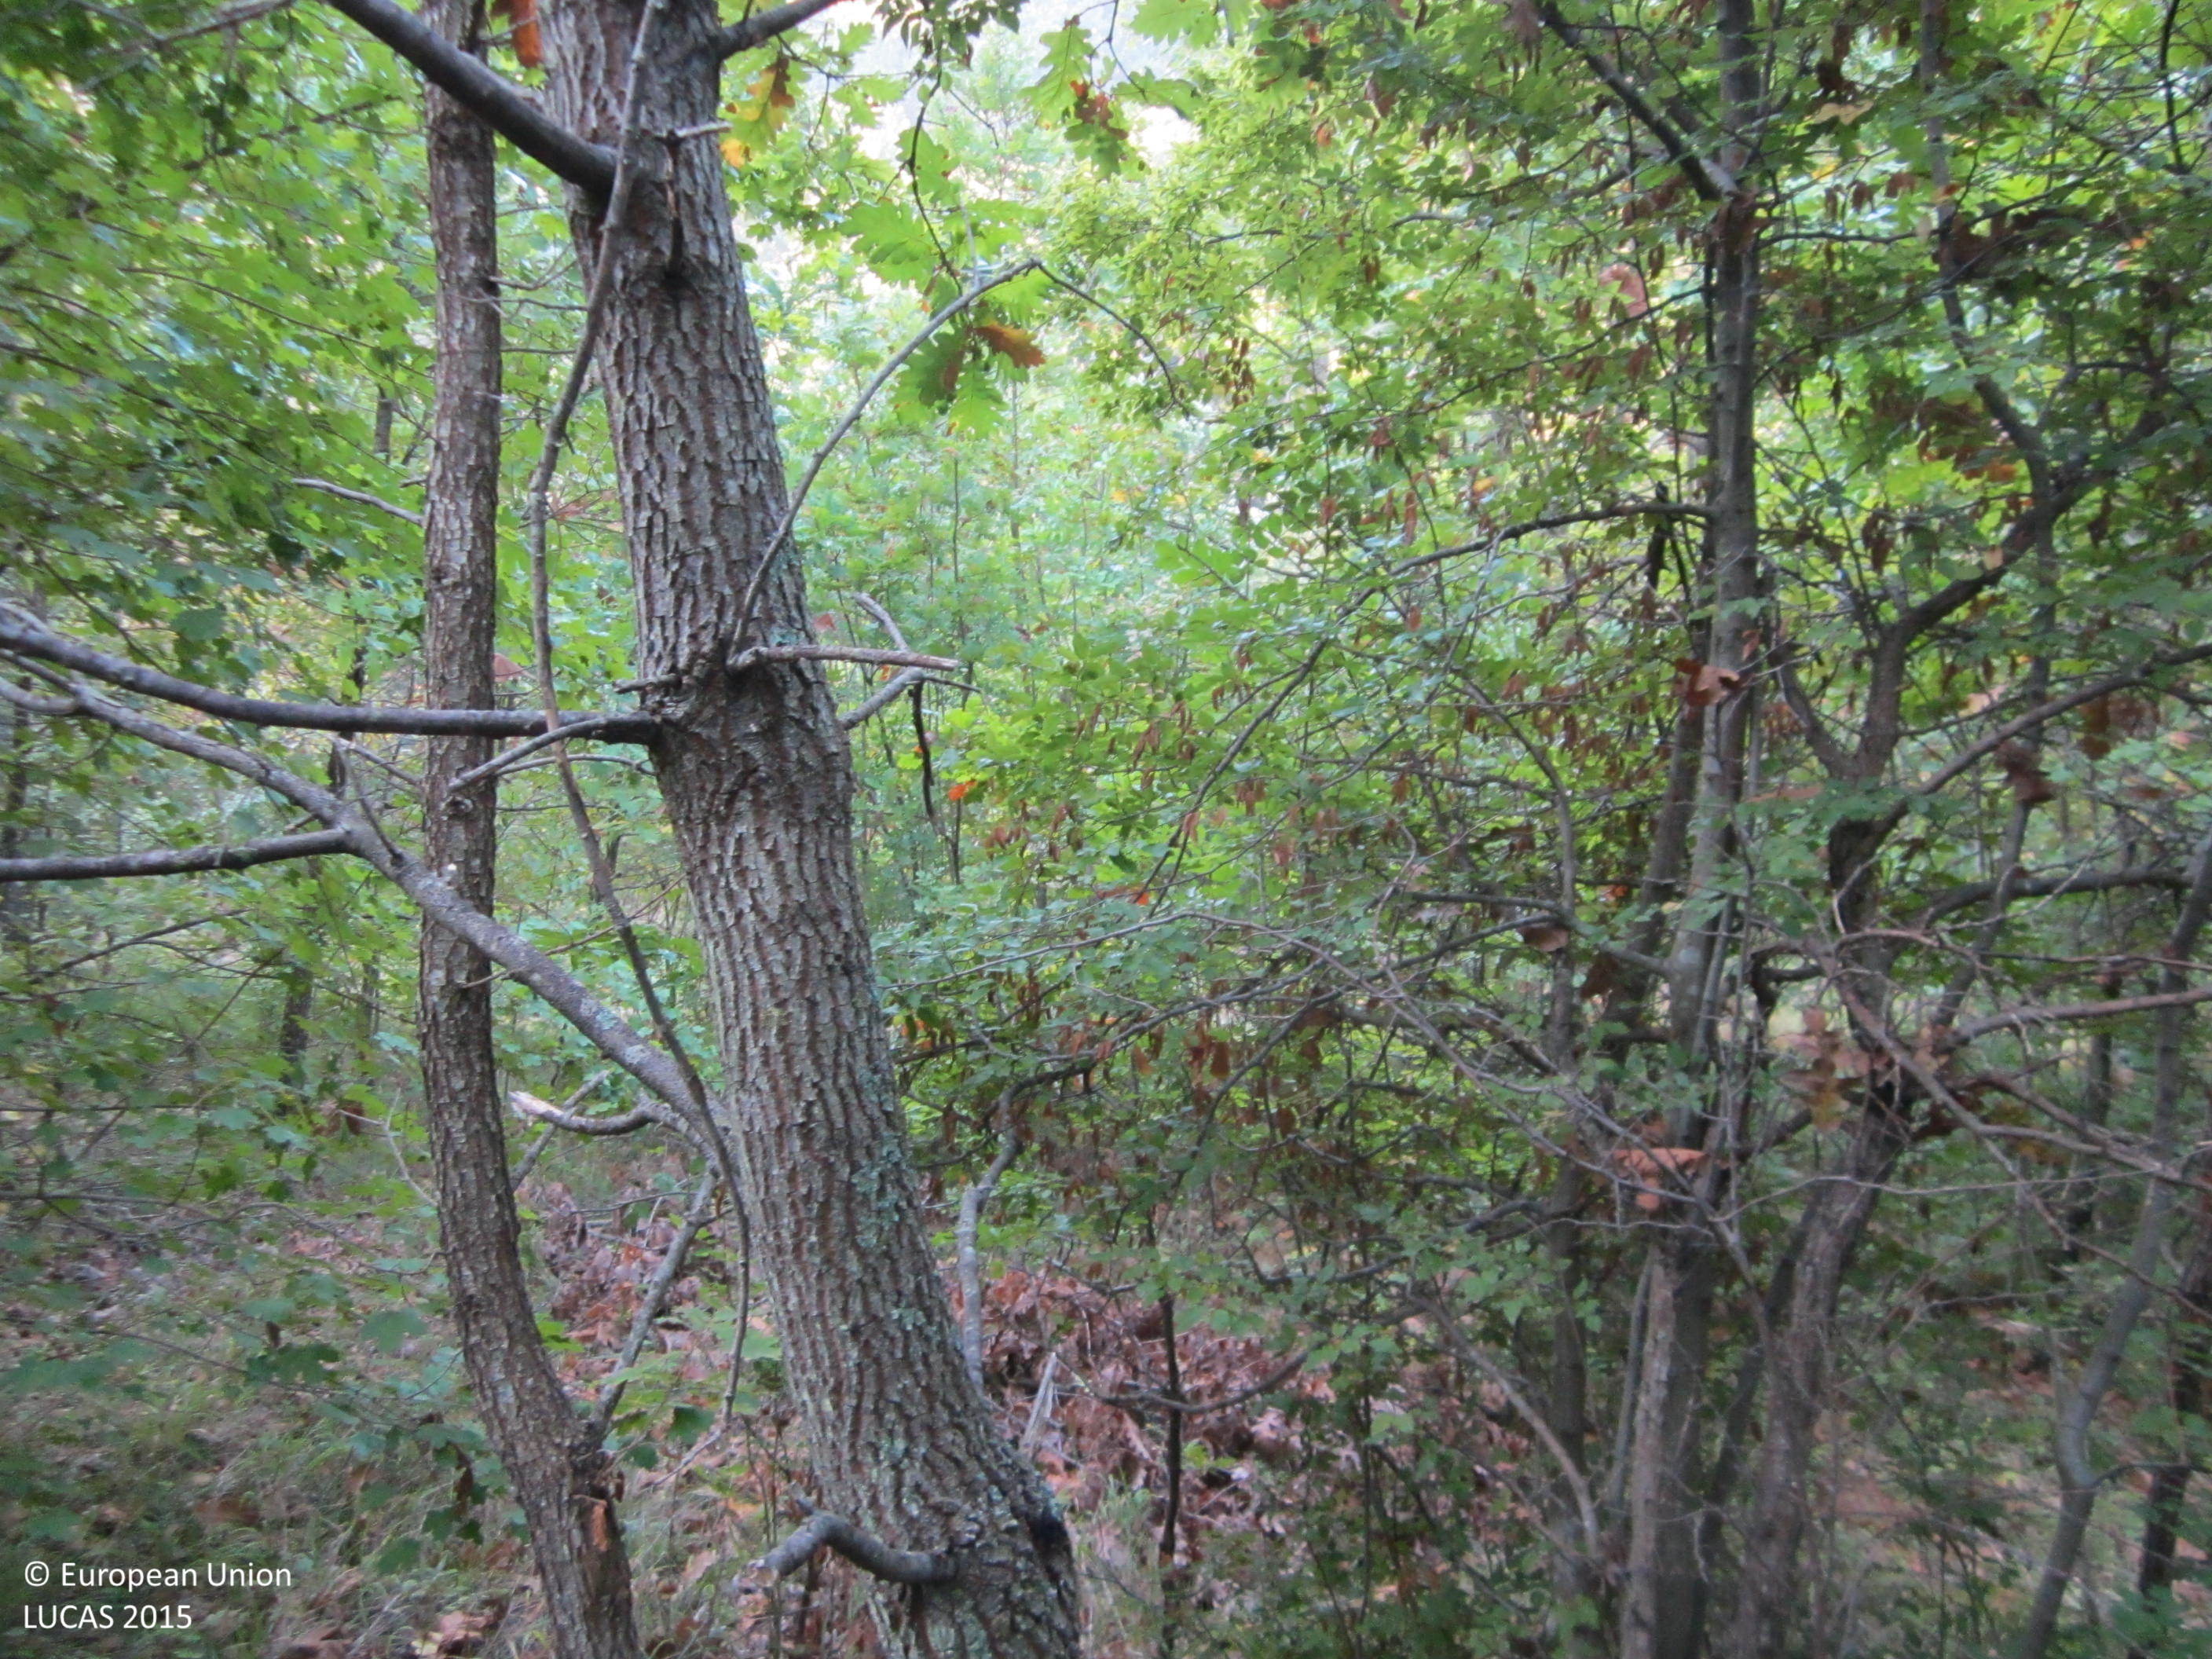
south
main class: Woodland
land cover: Broadleaved woodland
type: thermophilous deciduous forest
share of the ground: > 75 %
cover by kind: broadleaved forest trees 90 %, herbaceous plants 5 %, unconsolidated bare surface 5 %
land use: Forestry
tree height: > 5 m
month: September
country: BG
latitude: 42.1506
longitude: 27.8012
